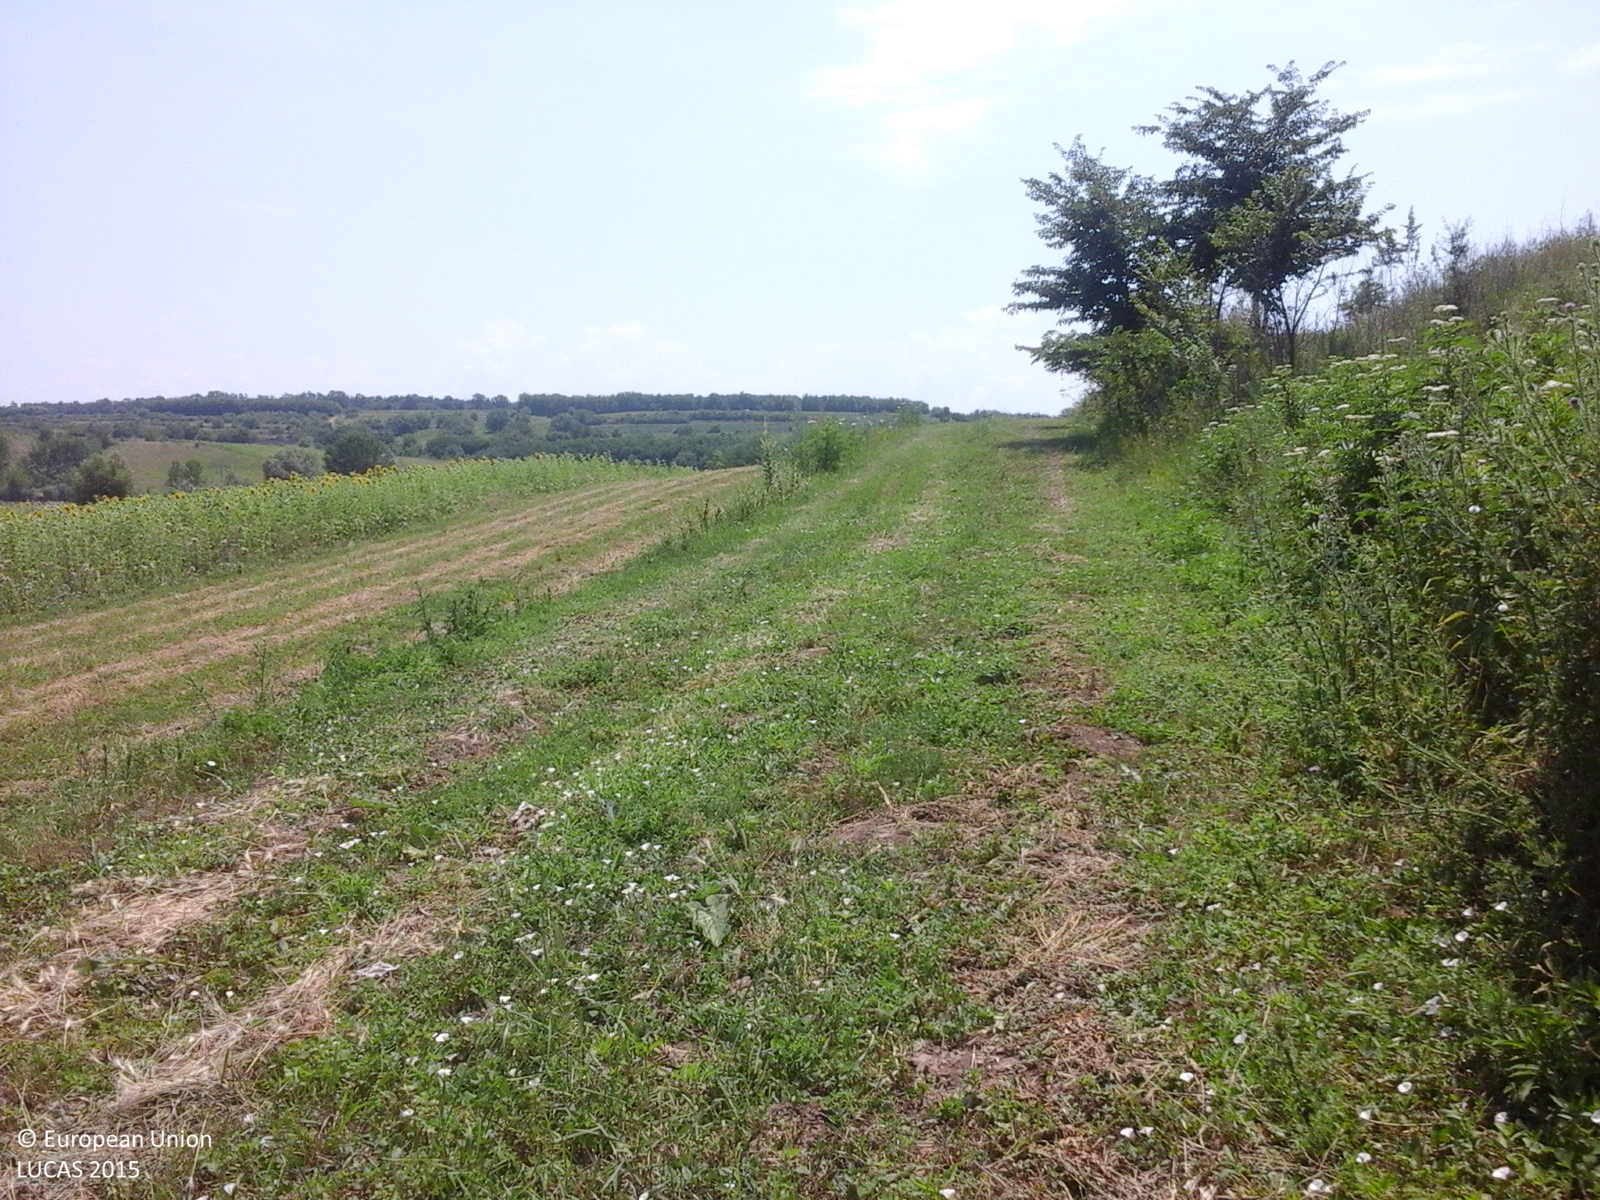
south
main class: Cropland
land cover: Lucerne
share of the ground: > 75 %
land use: Agriculture (excluding fallow land and kitchen gardens)
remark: Harvested field
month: July
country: RO
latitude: 44.1438
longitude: 26.4752
